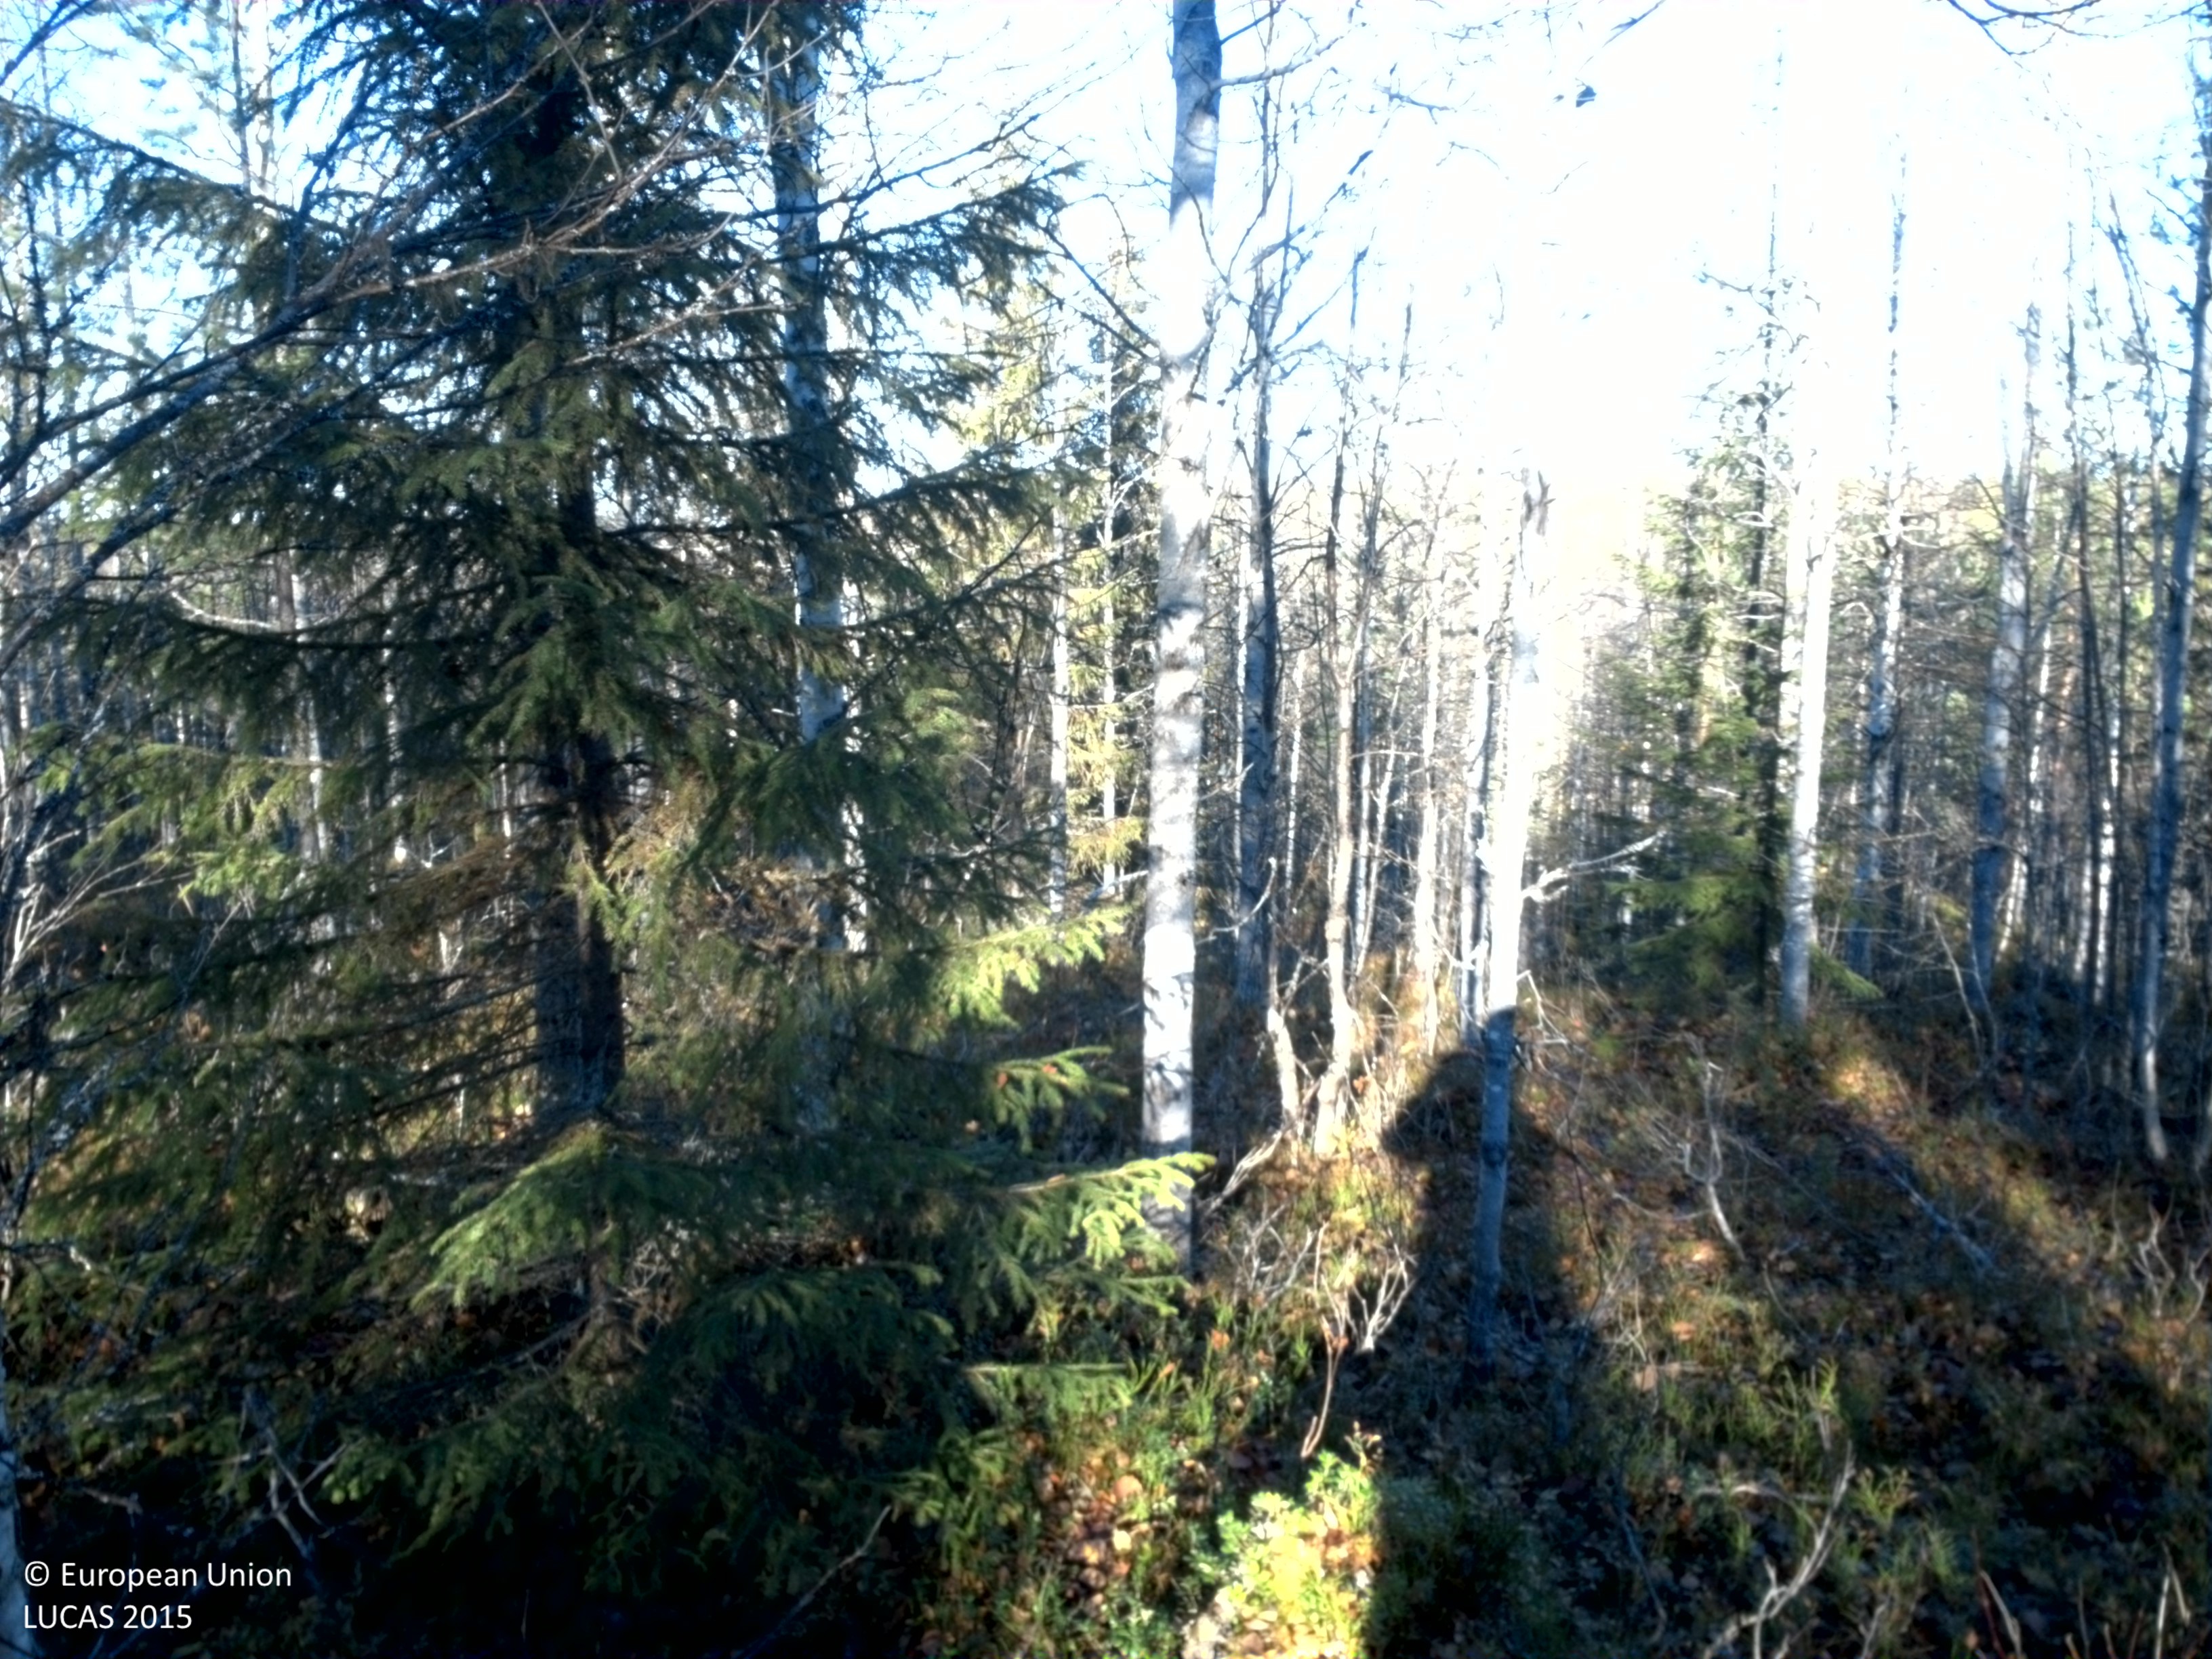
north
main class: Woodland
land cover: Broadleaved woodland
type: non-riverine alder, birch or aspen forest
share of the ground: 25 - 50 %
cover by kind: shrubs 40 %, broadleaved forest trees 35 %, lichens and mosses 15 %, coniferous forest trees 5 %, herbaceous plants 5 %
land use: Forestry
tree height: > 5 m
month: October
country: SE
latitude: 64.5714
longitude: 16.5423
